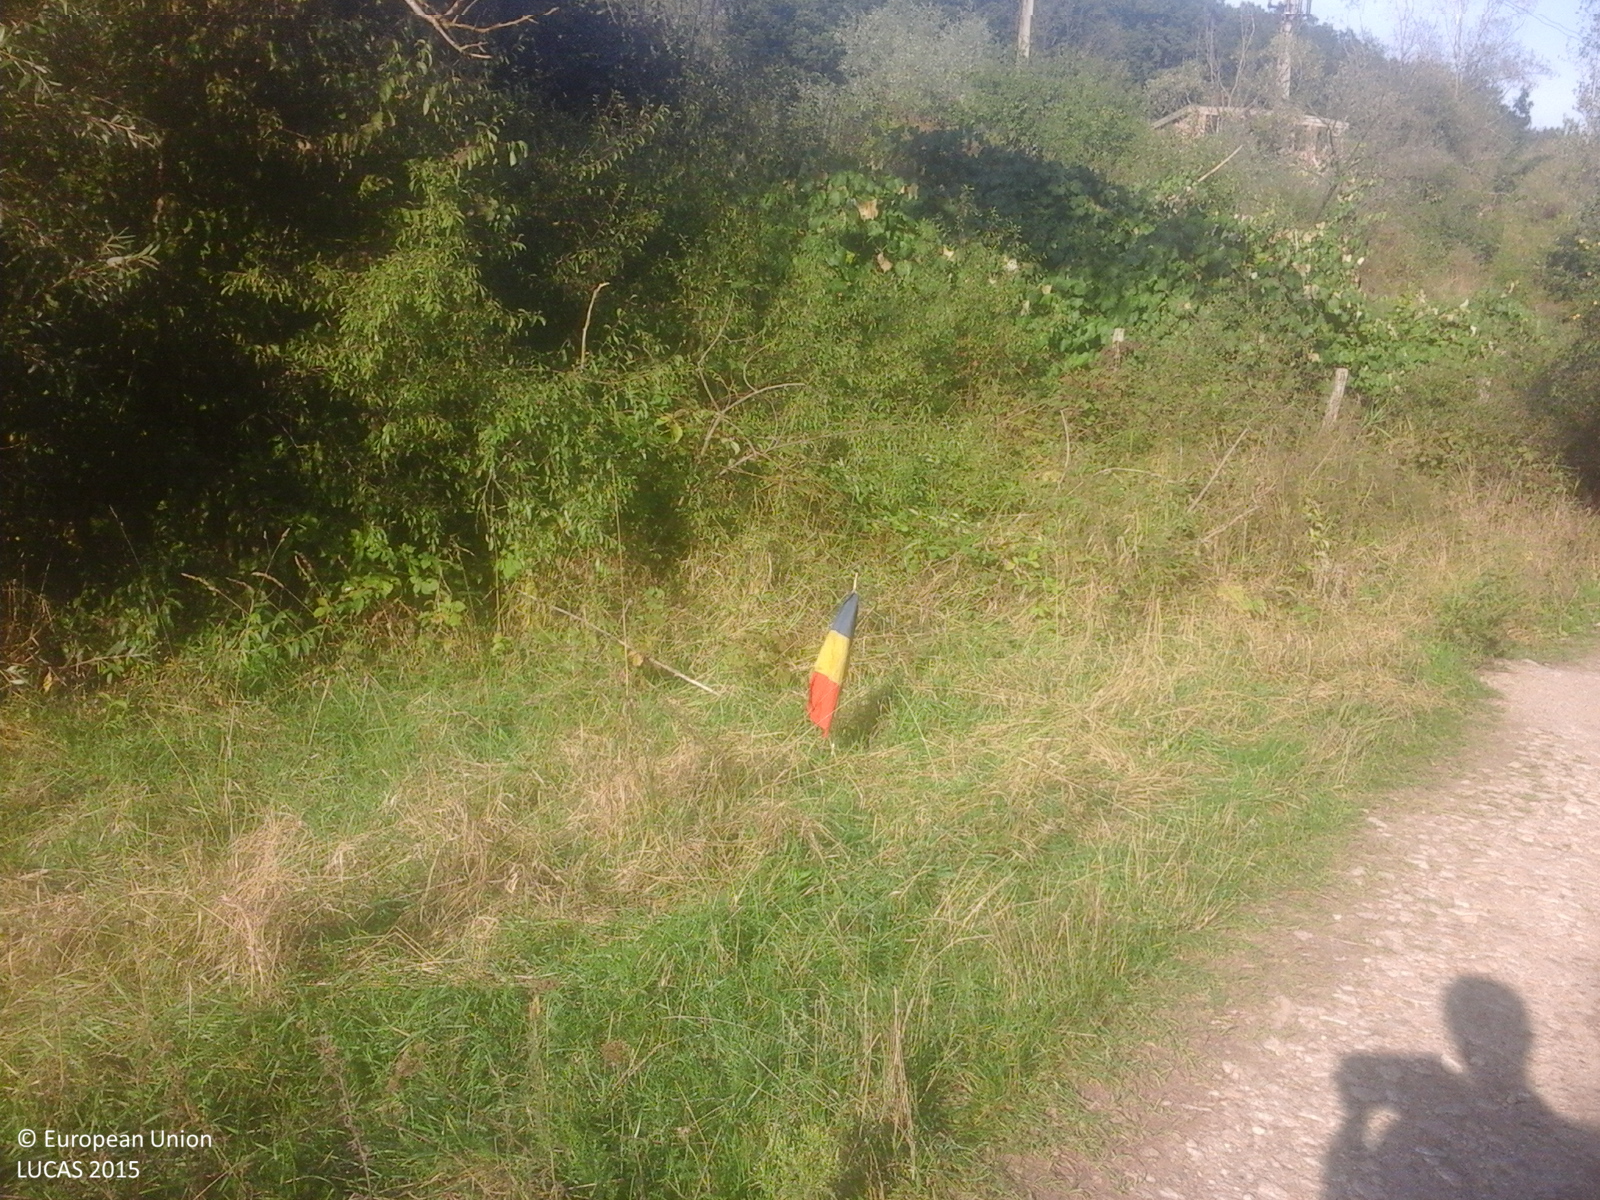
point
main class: Woodland
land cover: Broadleaved woodland
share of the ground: > 75 %
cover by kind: broadleaved forest trees 100 %
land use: Semi-natural and natural areas not in use
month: September
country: RO
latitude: 46.8867
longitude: 23.2816
